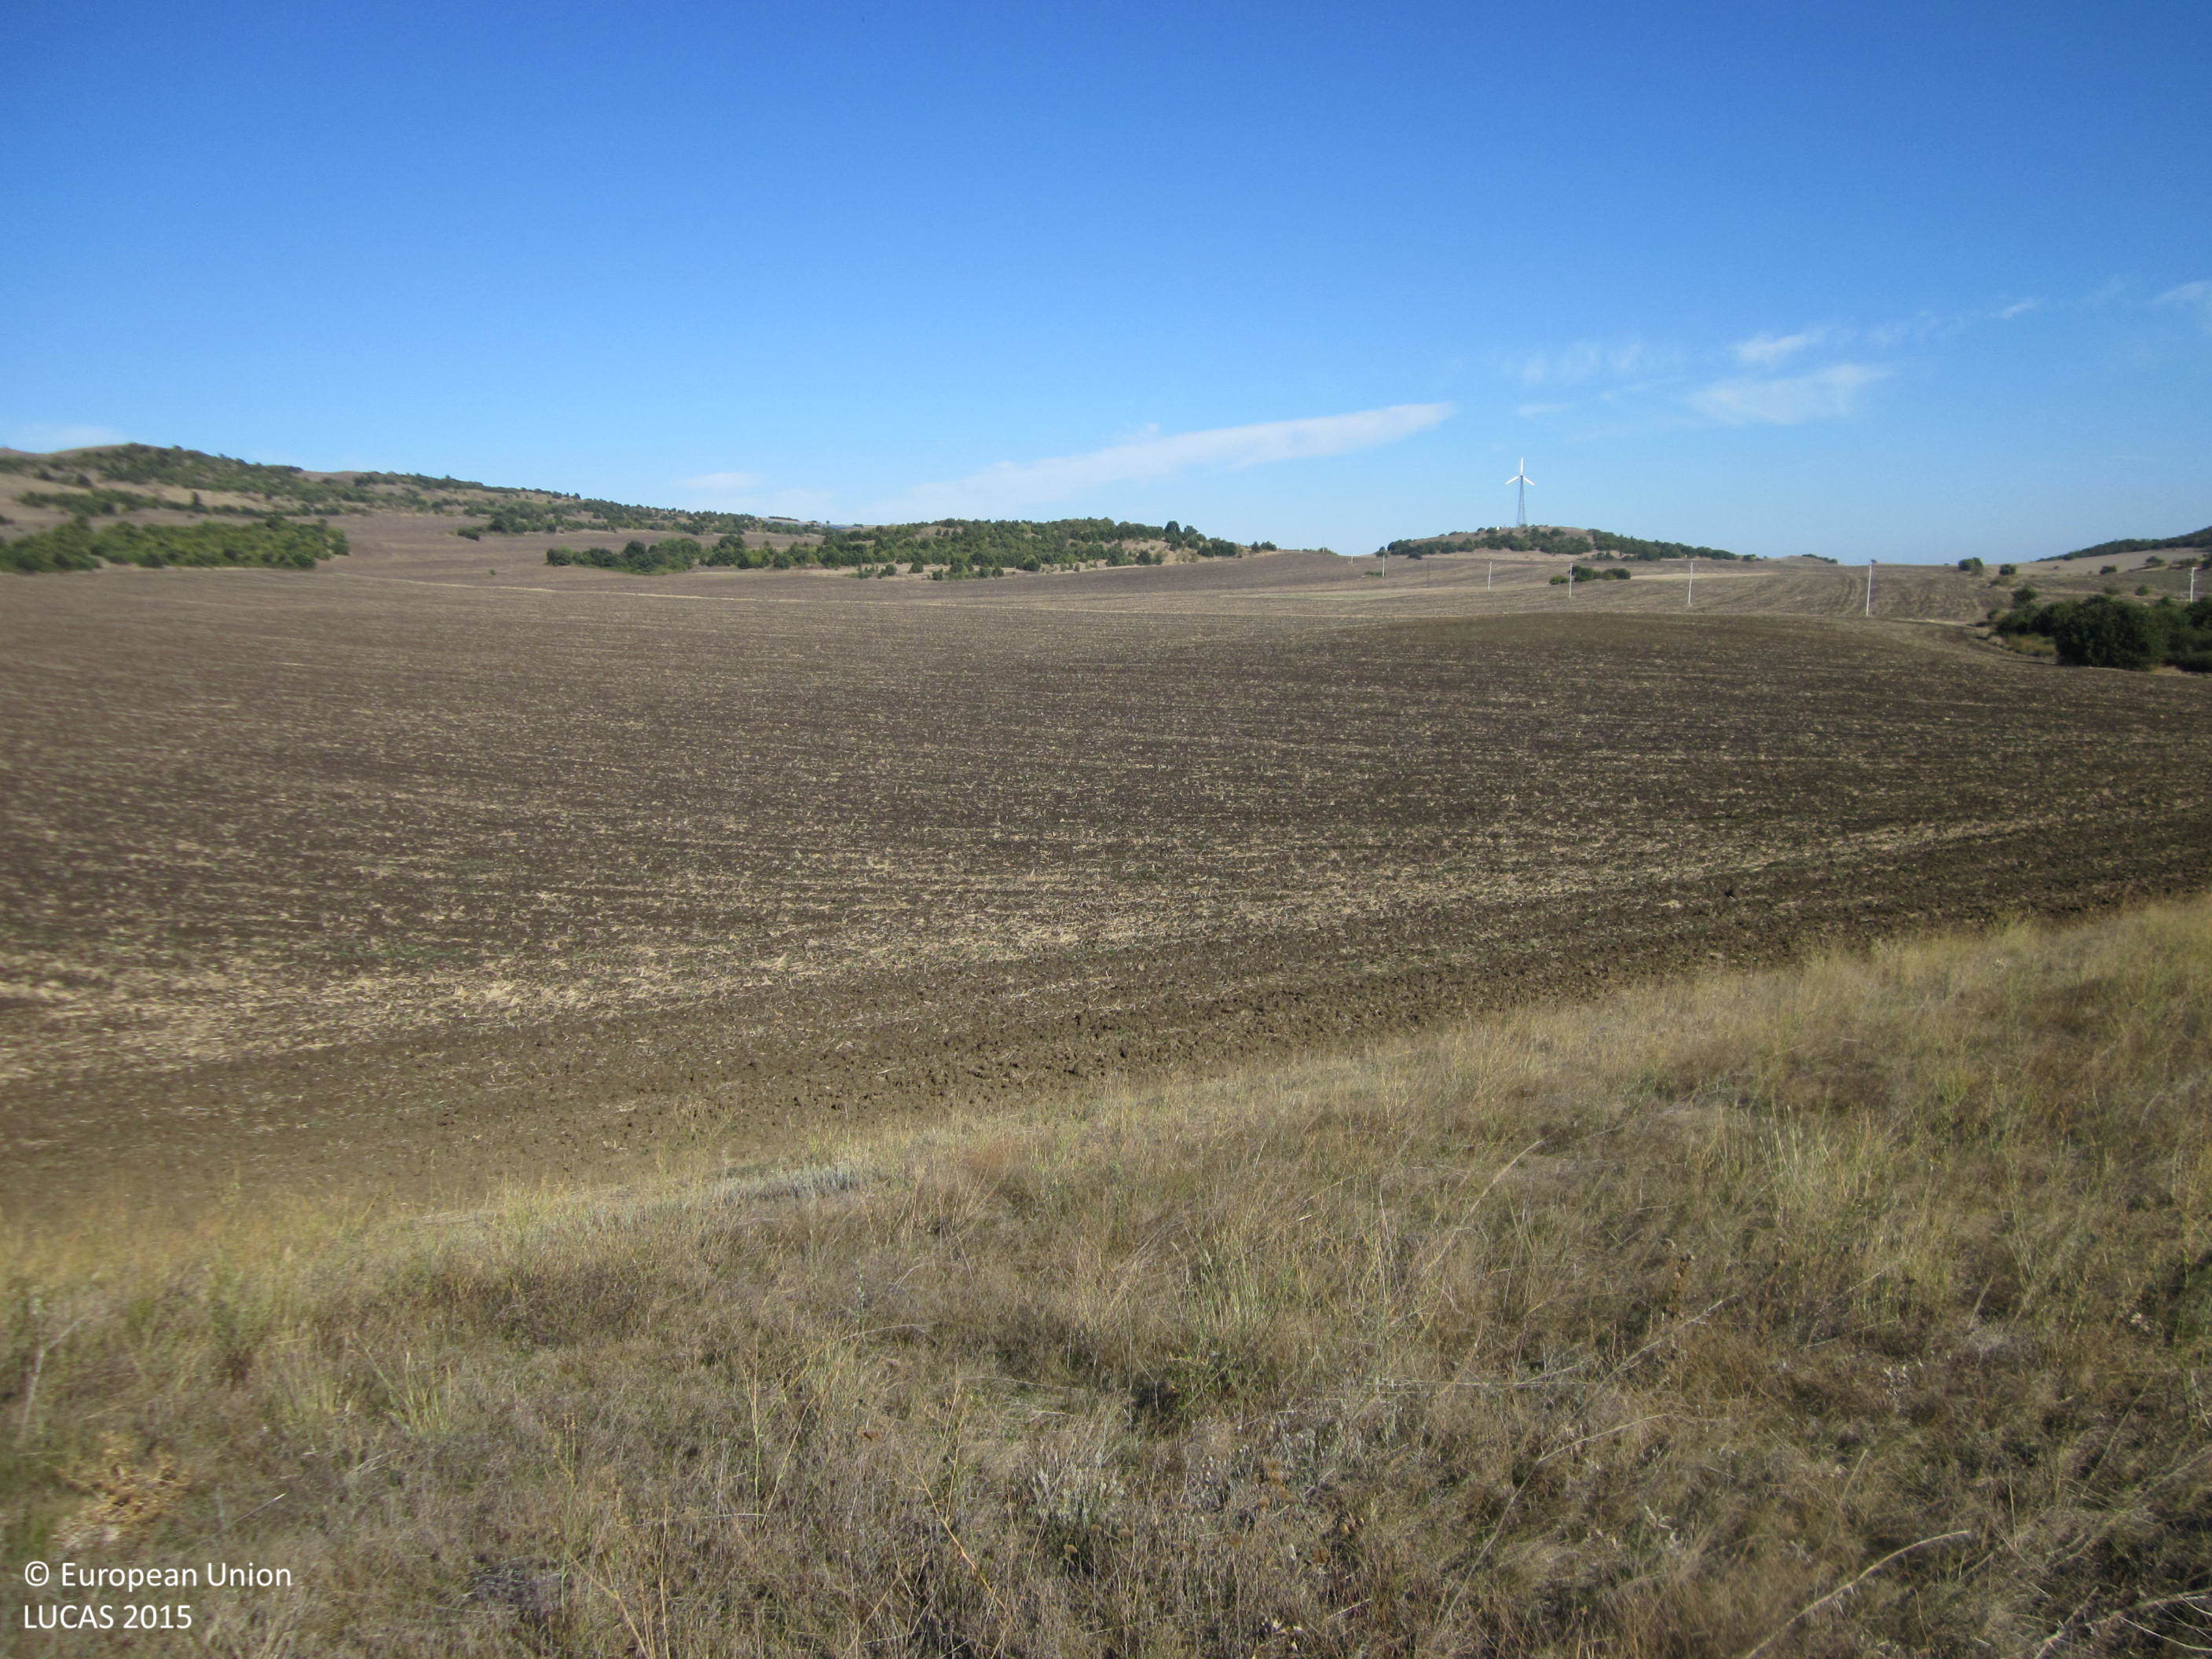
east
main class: Grassland
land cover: Grassland without tree/shrub cover
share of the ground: > 75 %
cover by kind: herbaceous plants 100 %
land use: Agriculture (excluding fallow land and kitchen gardens)
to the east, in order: Grassland without tree/shrub cover; Tracks; Grass margins; Common wheat
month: September
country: BG
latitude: 42.7363
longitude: 27.3016
